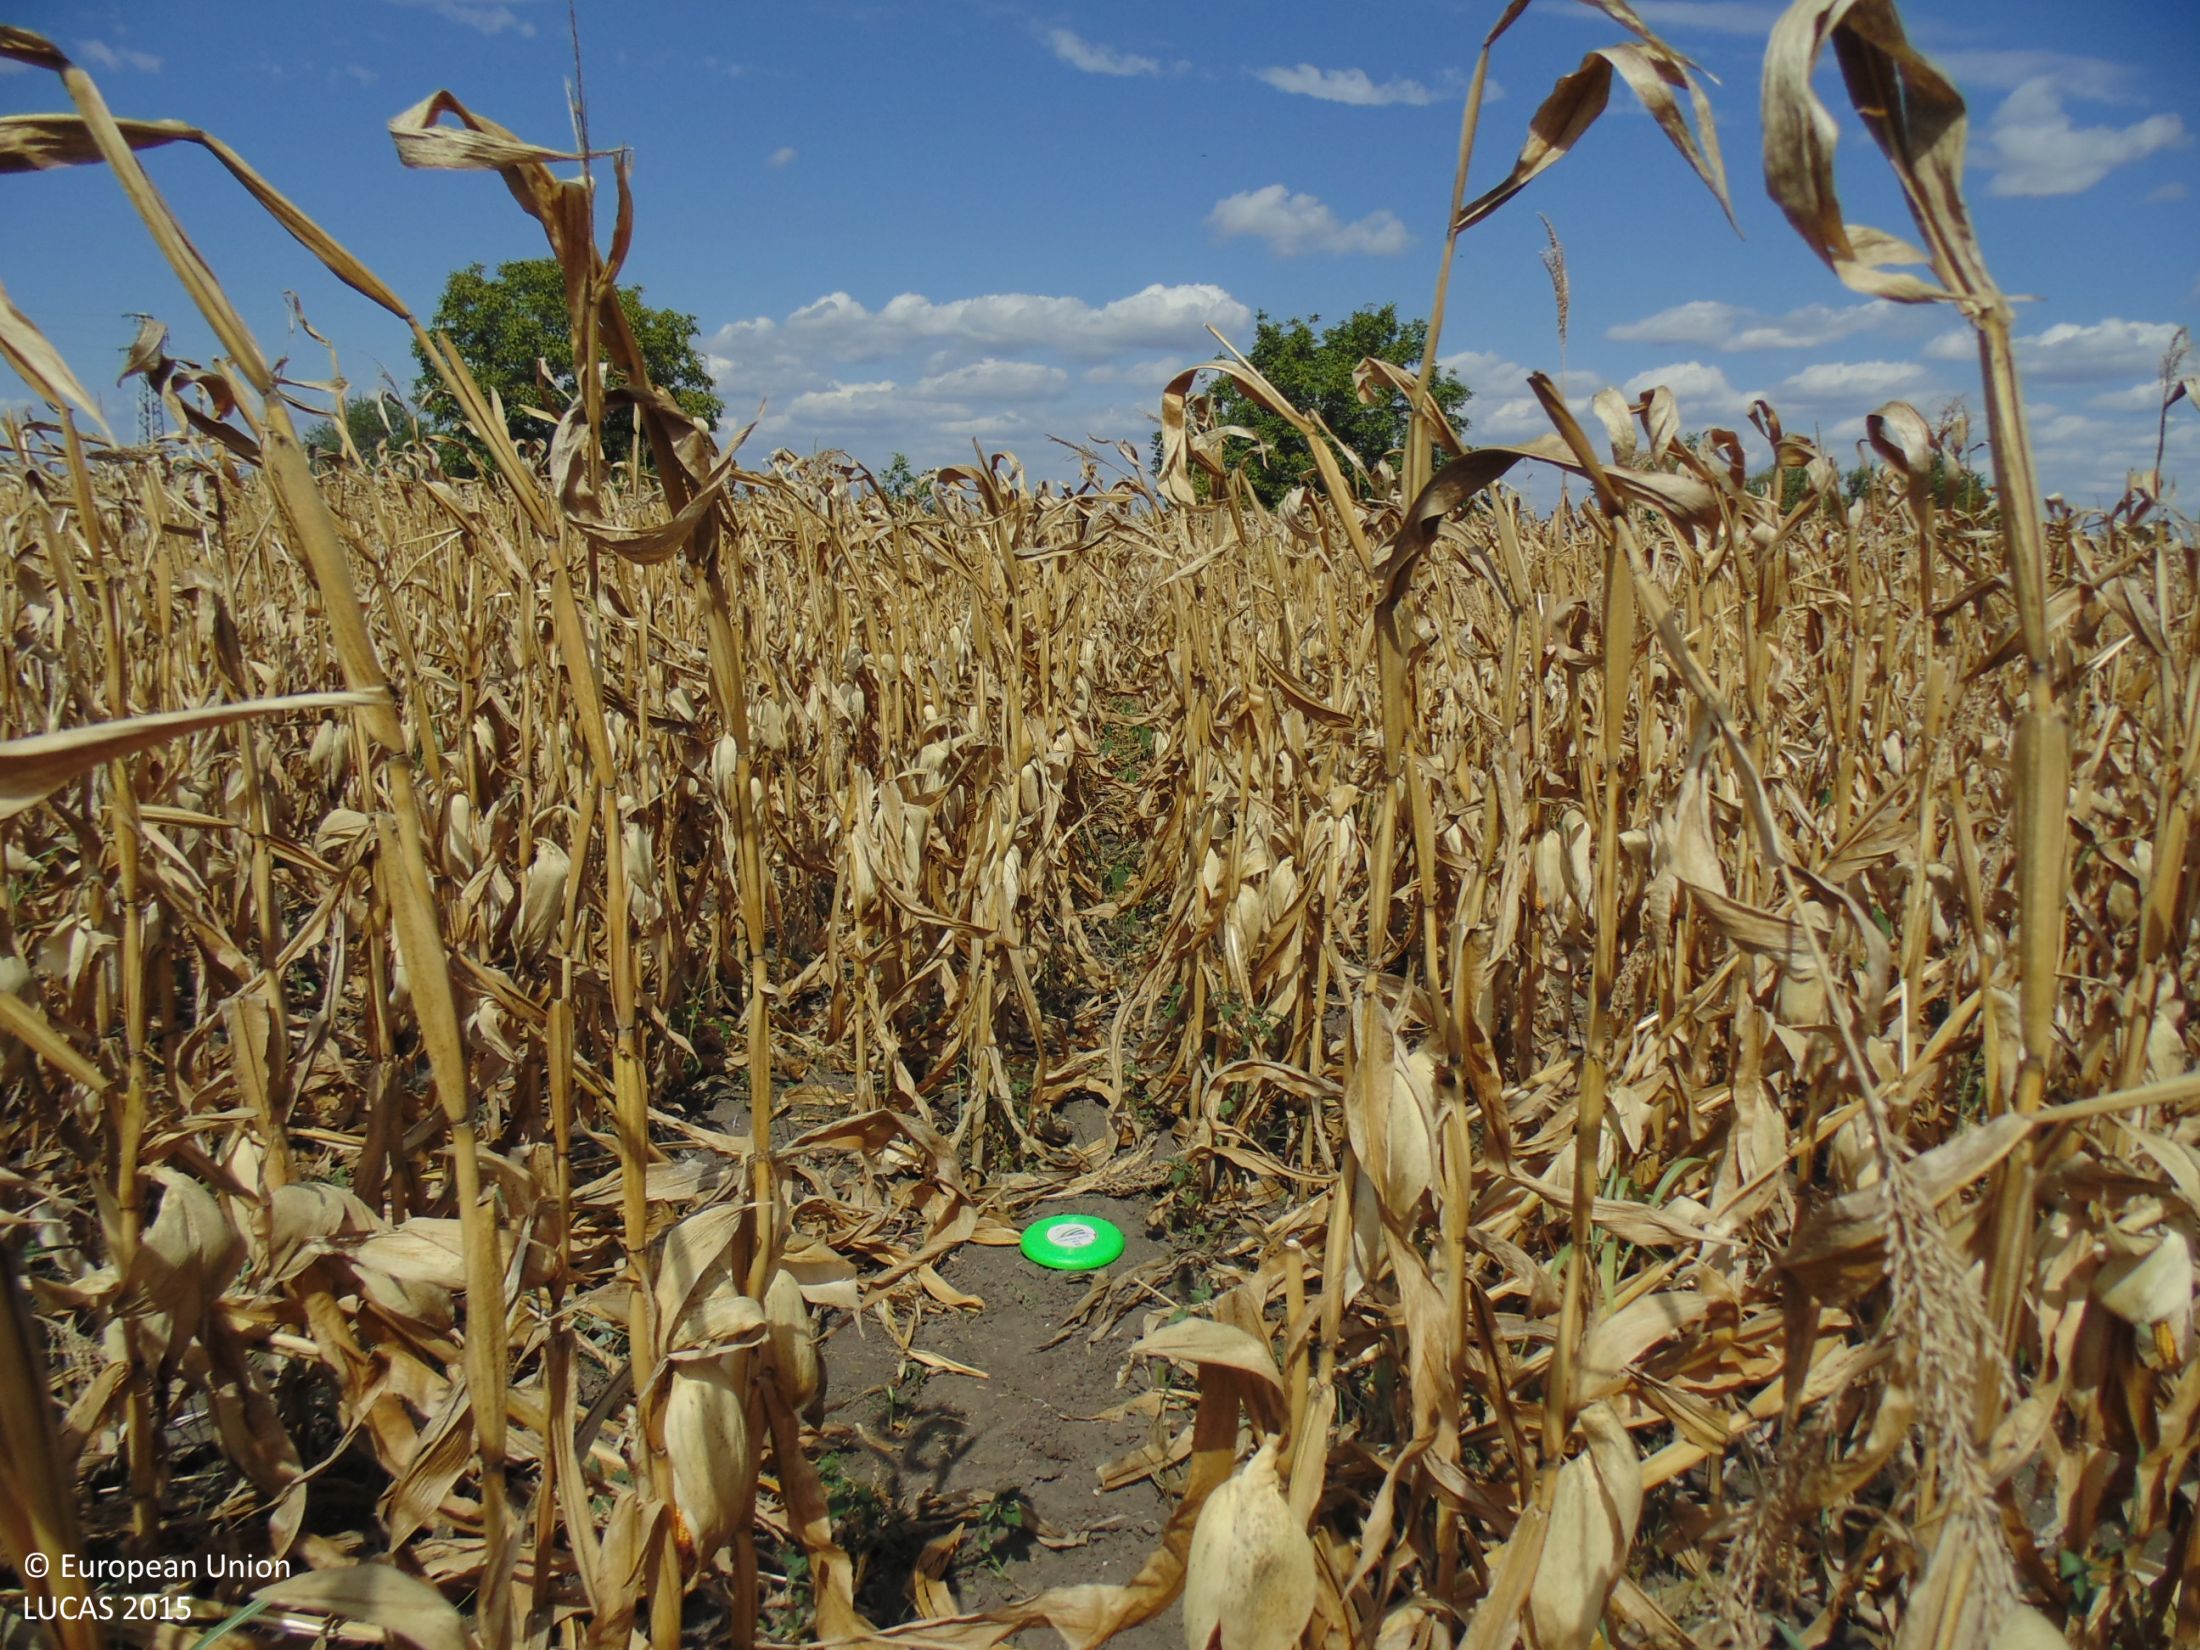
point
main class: Cropland
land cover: Maize
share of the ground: > 75 %
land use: Agriculture (excluding fallow land and kitchen gardens)
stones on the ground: < 10 %
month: September
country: BG
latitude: 44.1051
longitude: 27.1566
